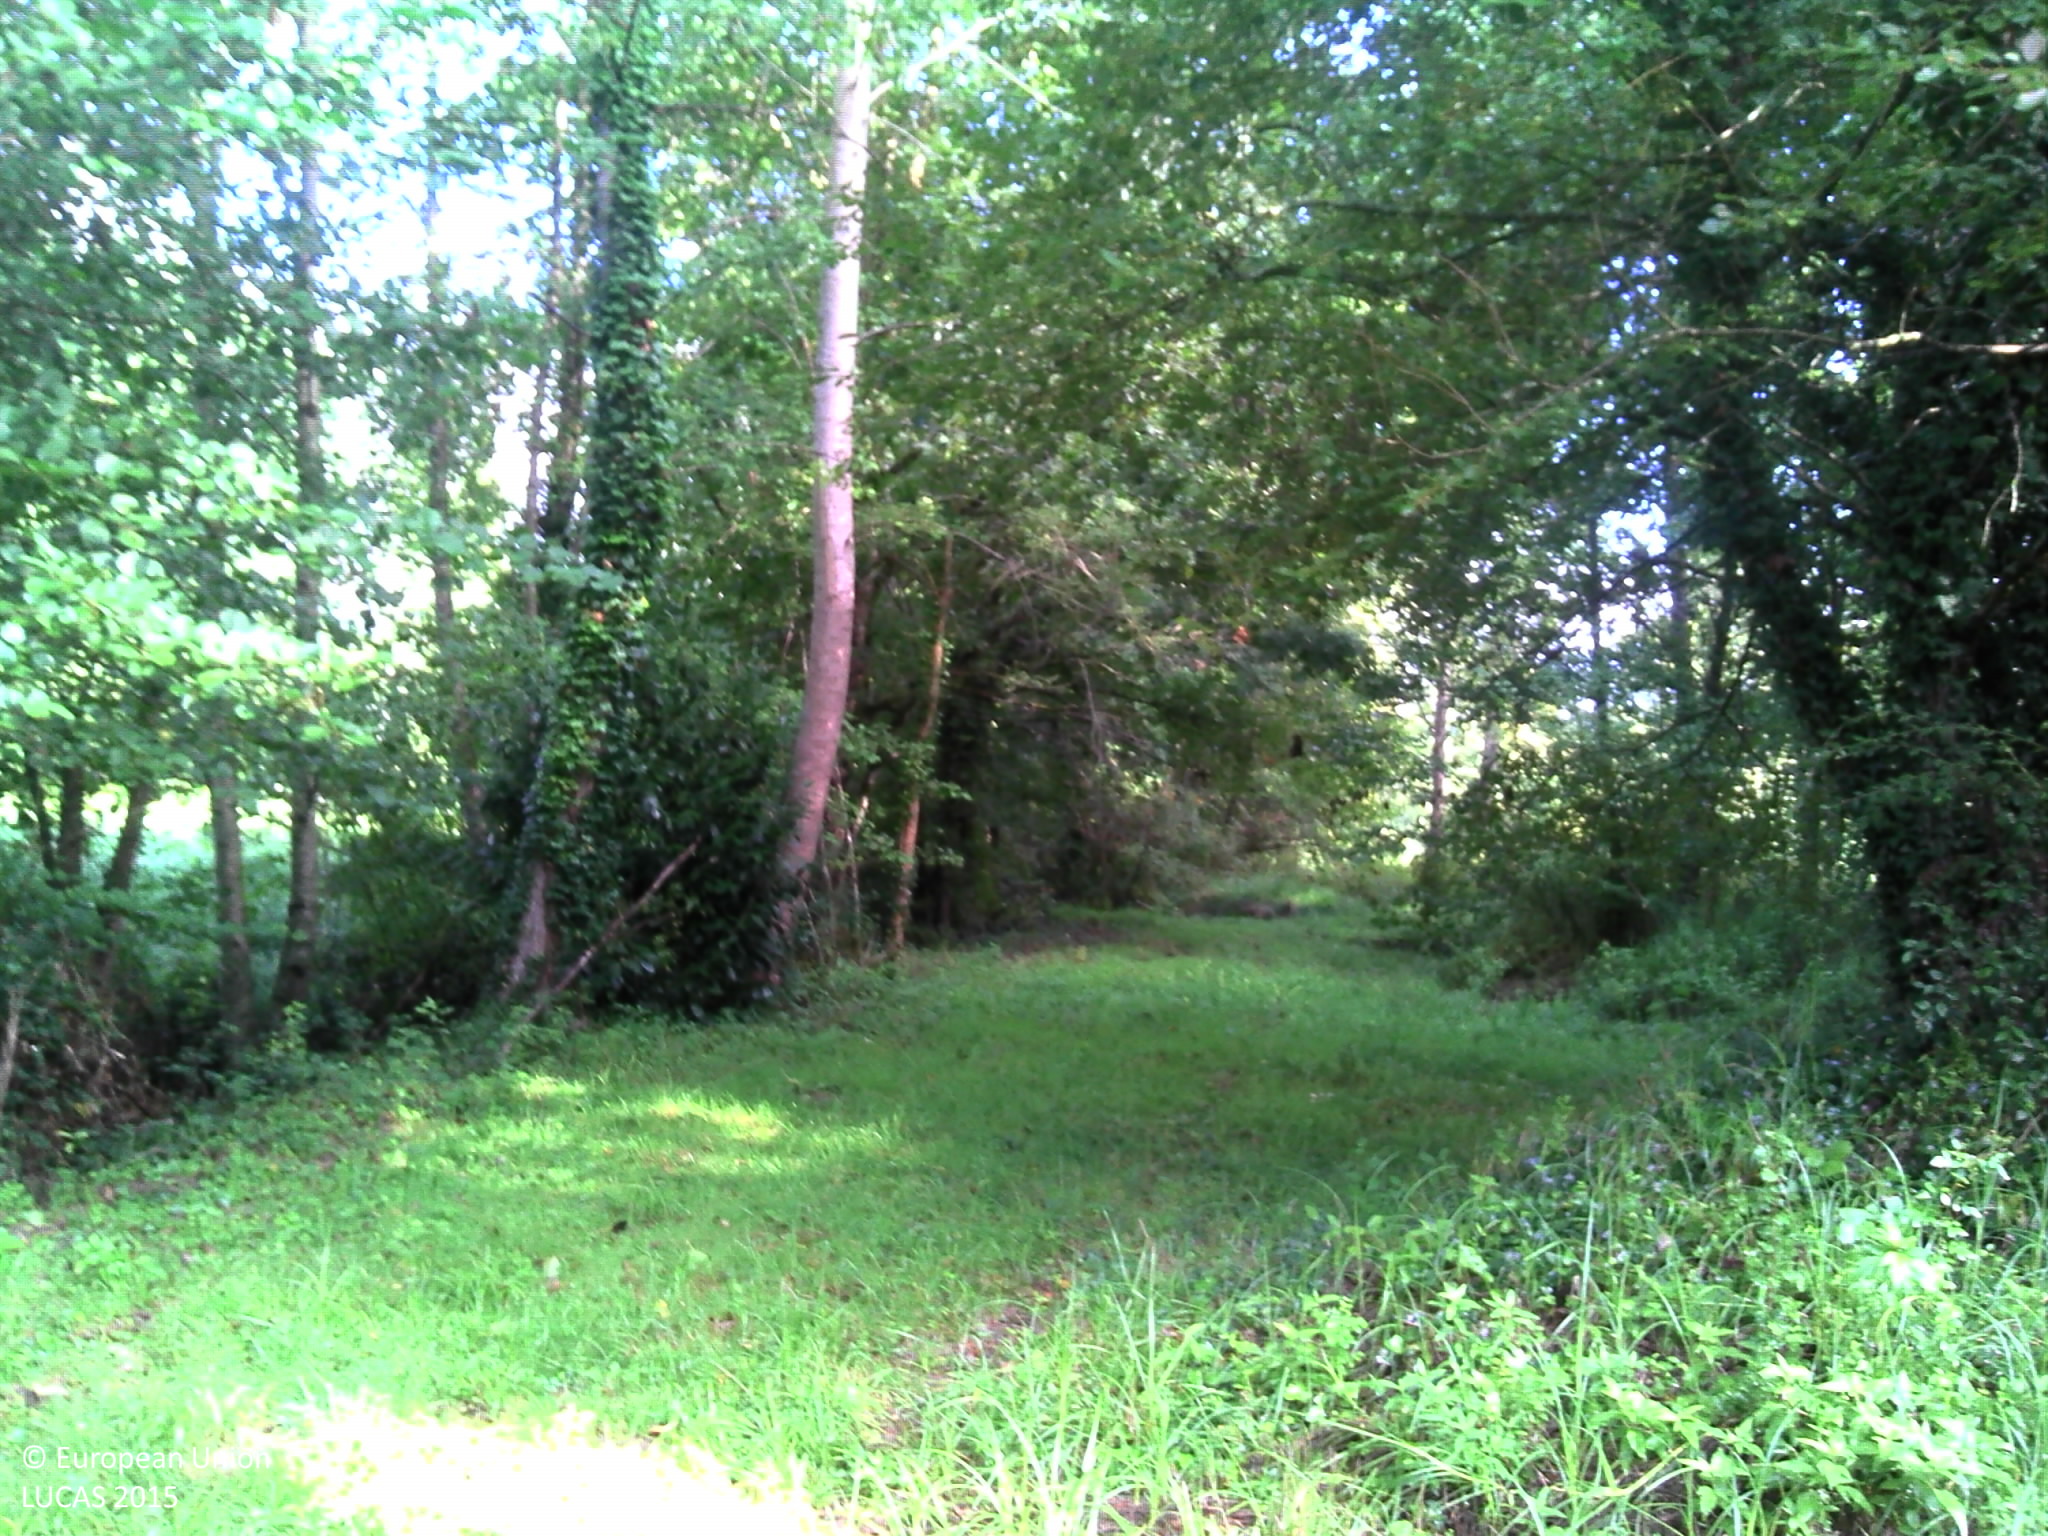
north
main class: Grassland
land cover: Grassland without tree/shrub cover
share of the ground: > 75 %
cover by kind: herbaceous plants 100 %
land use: Agriculture (excluding fallow land and kitchen gardens)
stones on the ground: < 10 %
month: September
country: FR
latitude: 44.8976
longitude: 1.6011
